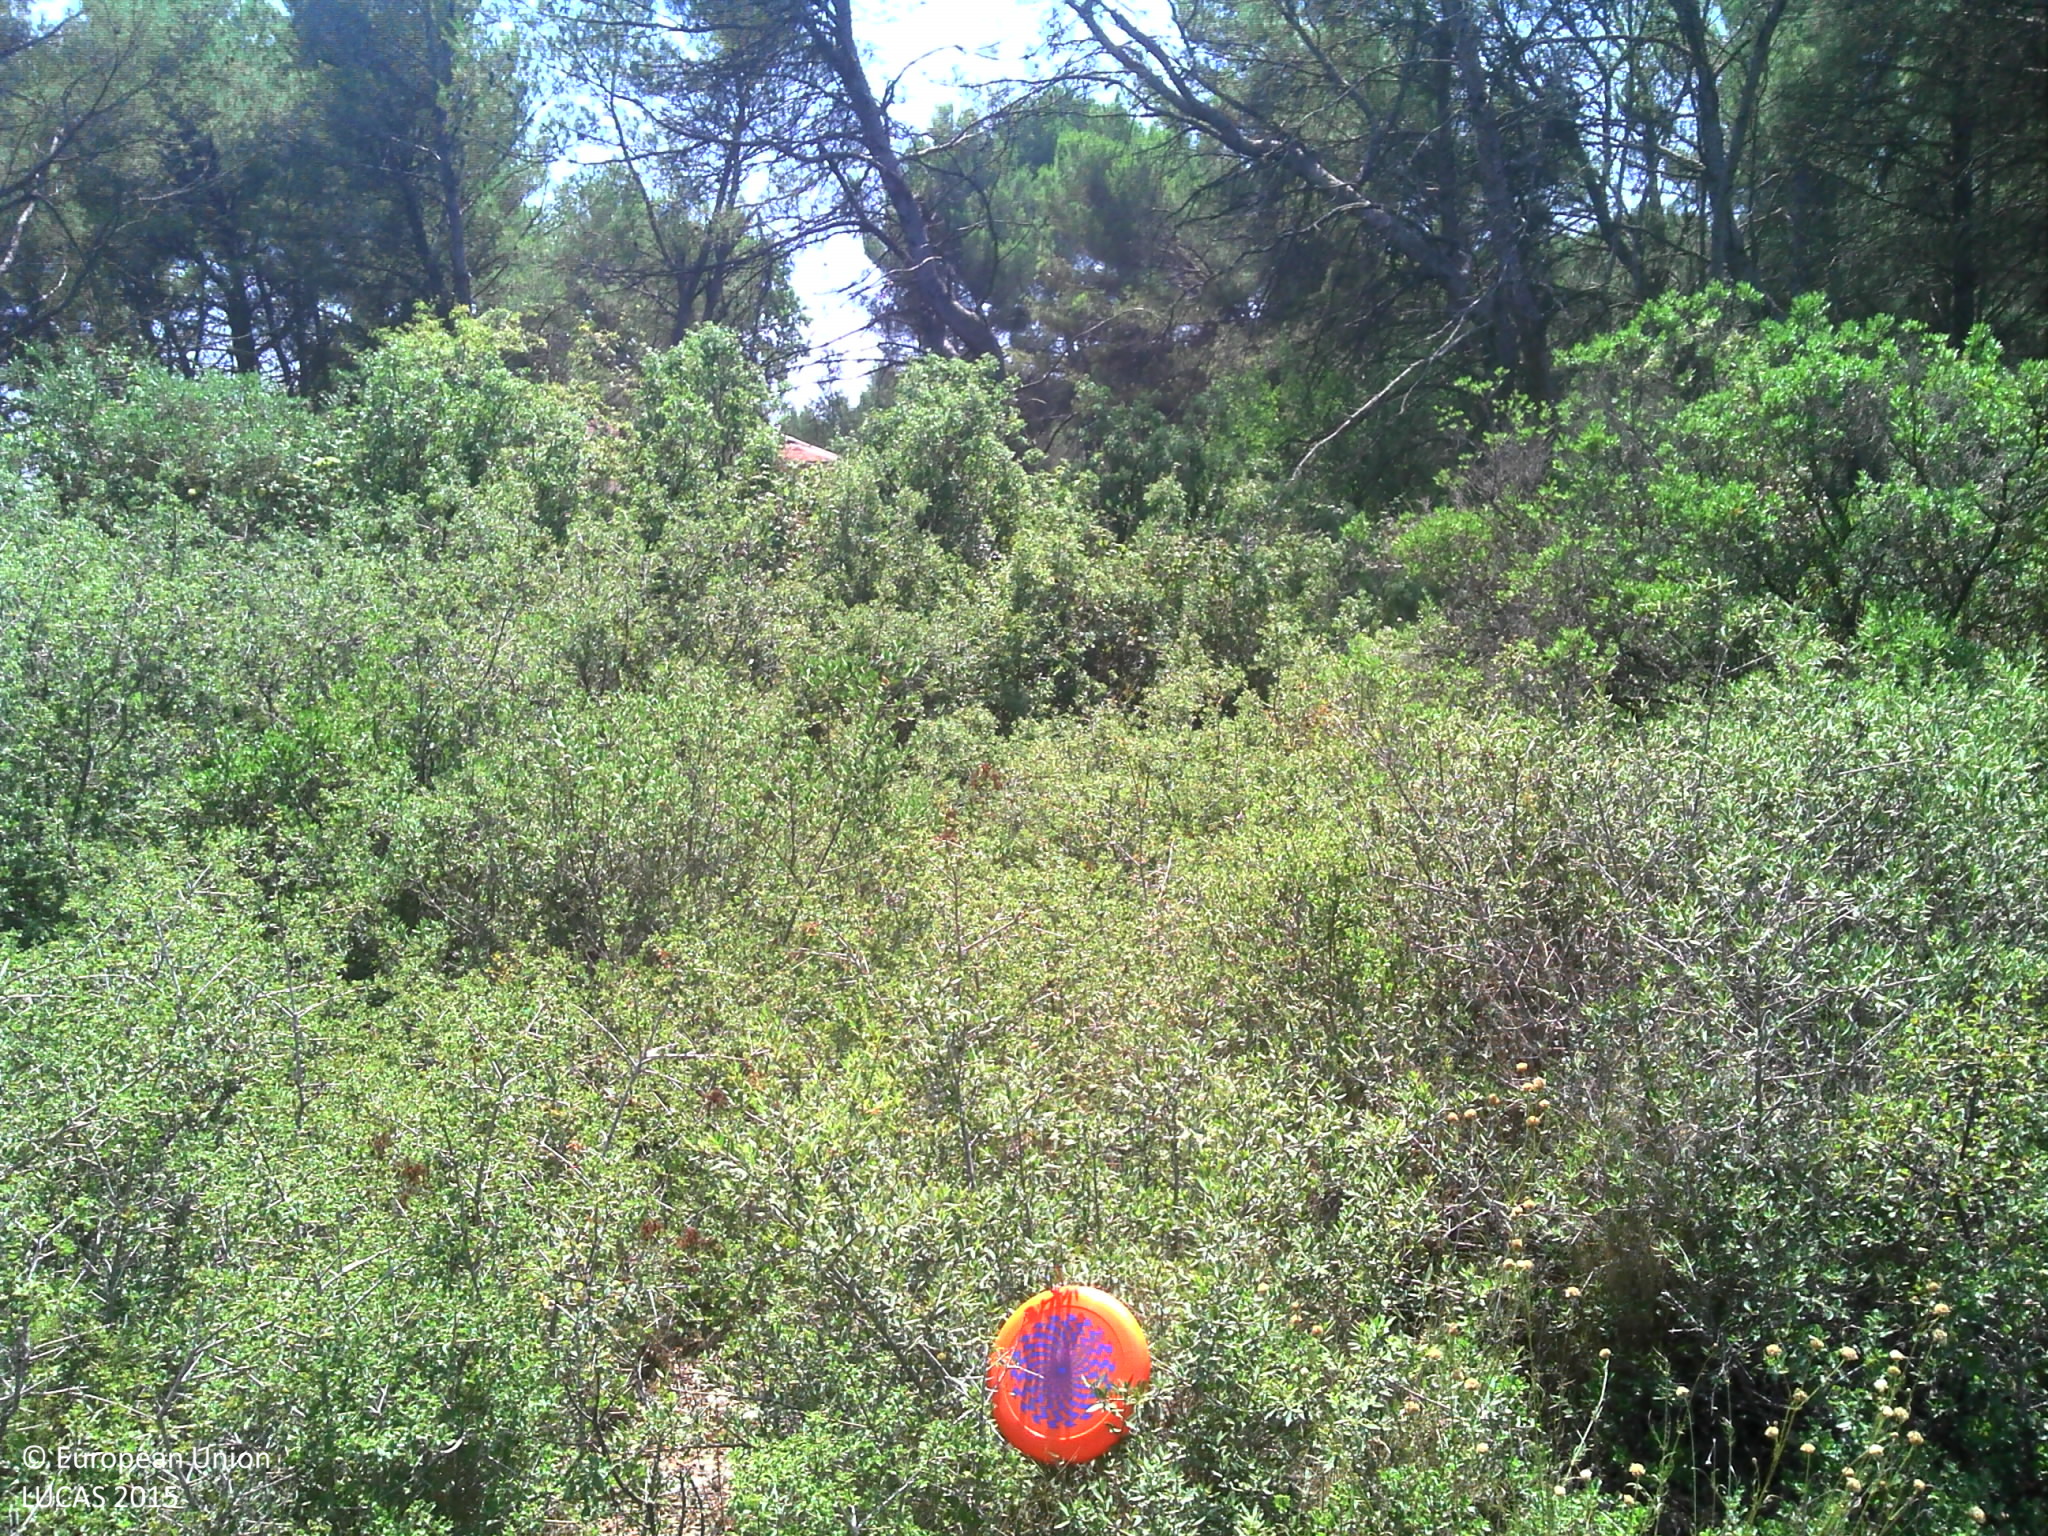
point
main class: Shrubland
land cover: Shrubland without tree cover
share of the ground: > 75 %
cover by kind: shrubs 80 %, herbaceous plants 15 %, unconsolidated bare surface 5 %
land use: Semi-natural and natural areas not in use
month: August
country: FR
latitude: 43.5234
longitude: 5.3454
